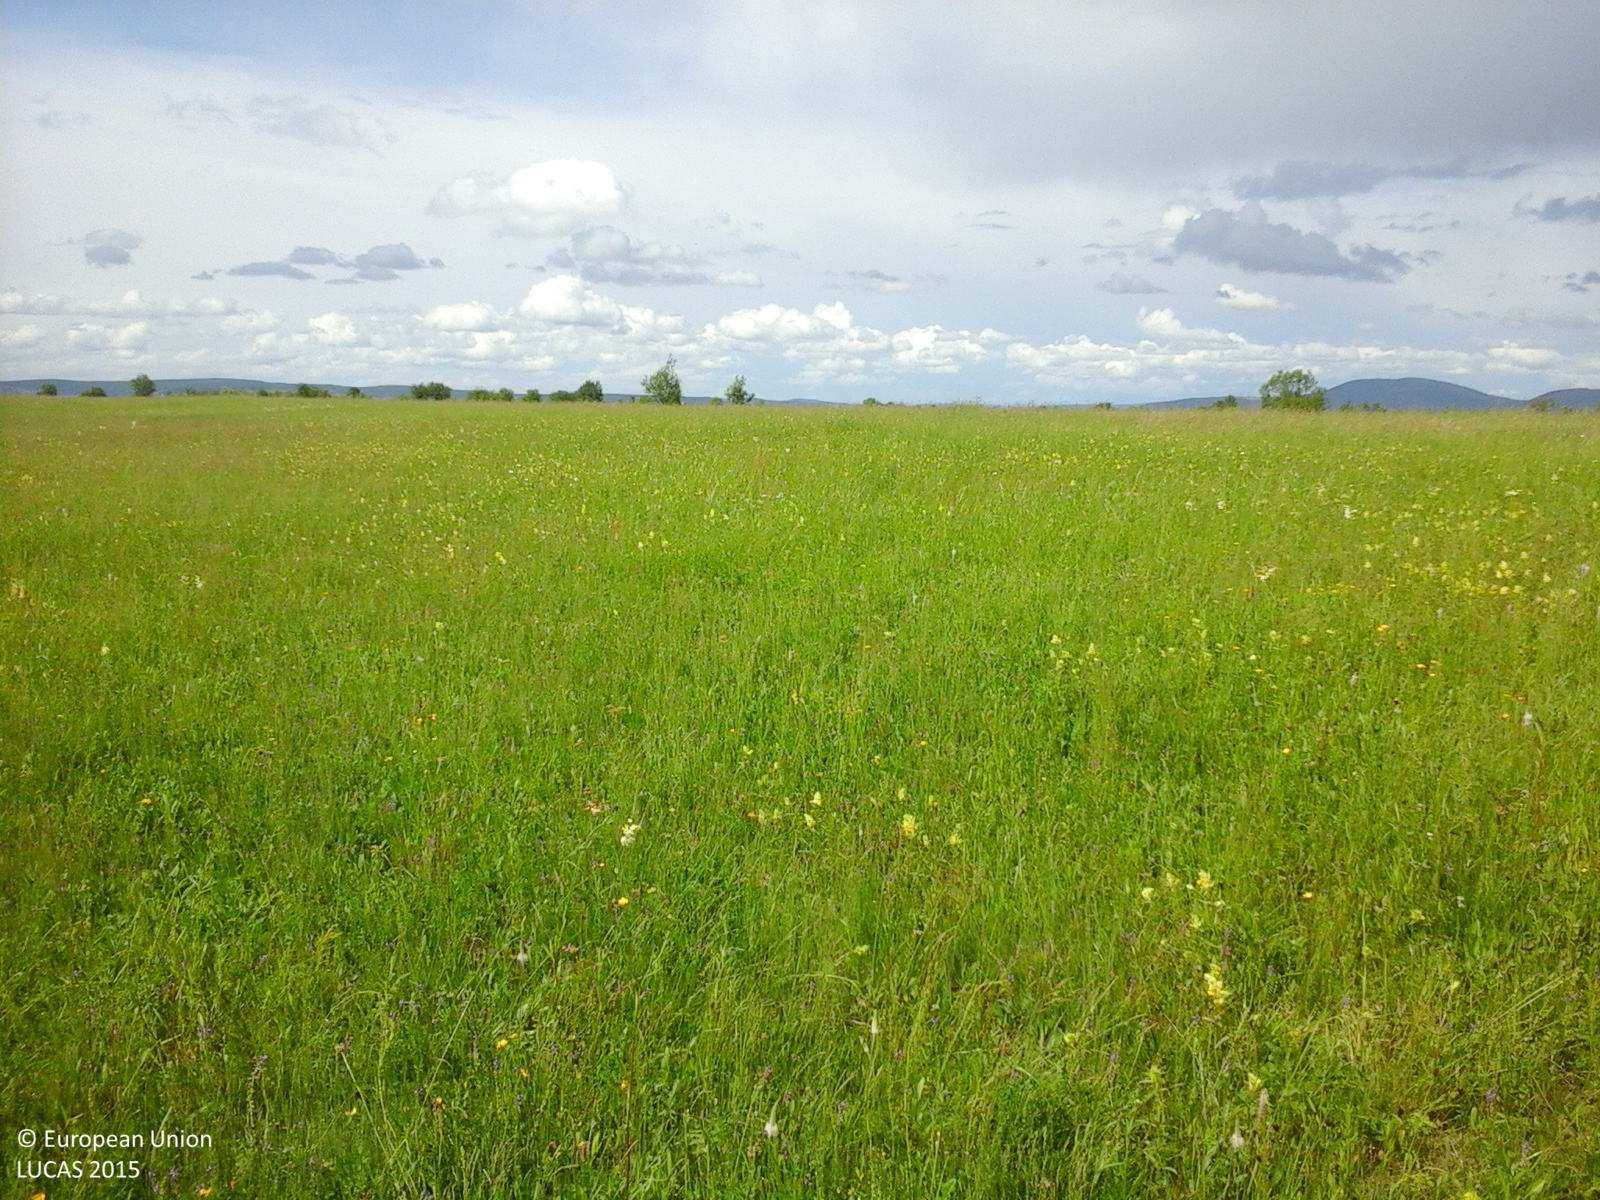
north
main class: Cropland
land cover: Other leguminous and mixtures for fodder
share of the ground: > 75 %
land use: Agriculture (excluding fallow land and kitchen gardens)
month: May
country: RO
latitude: 45.7939
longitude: 25.1603
